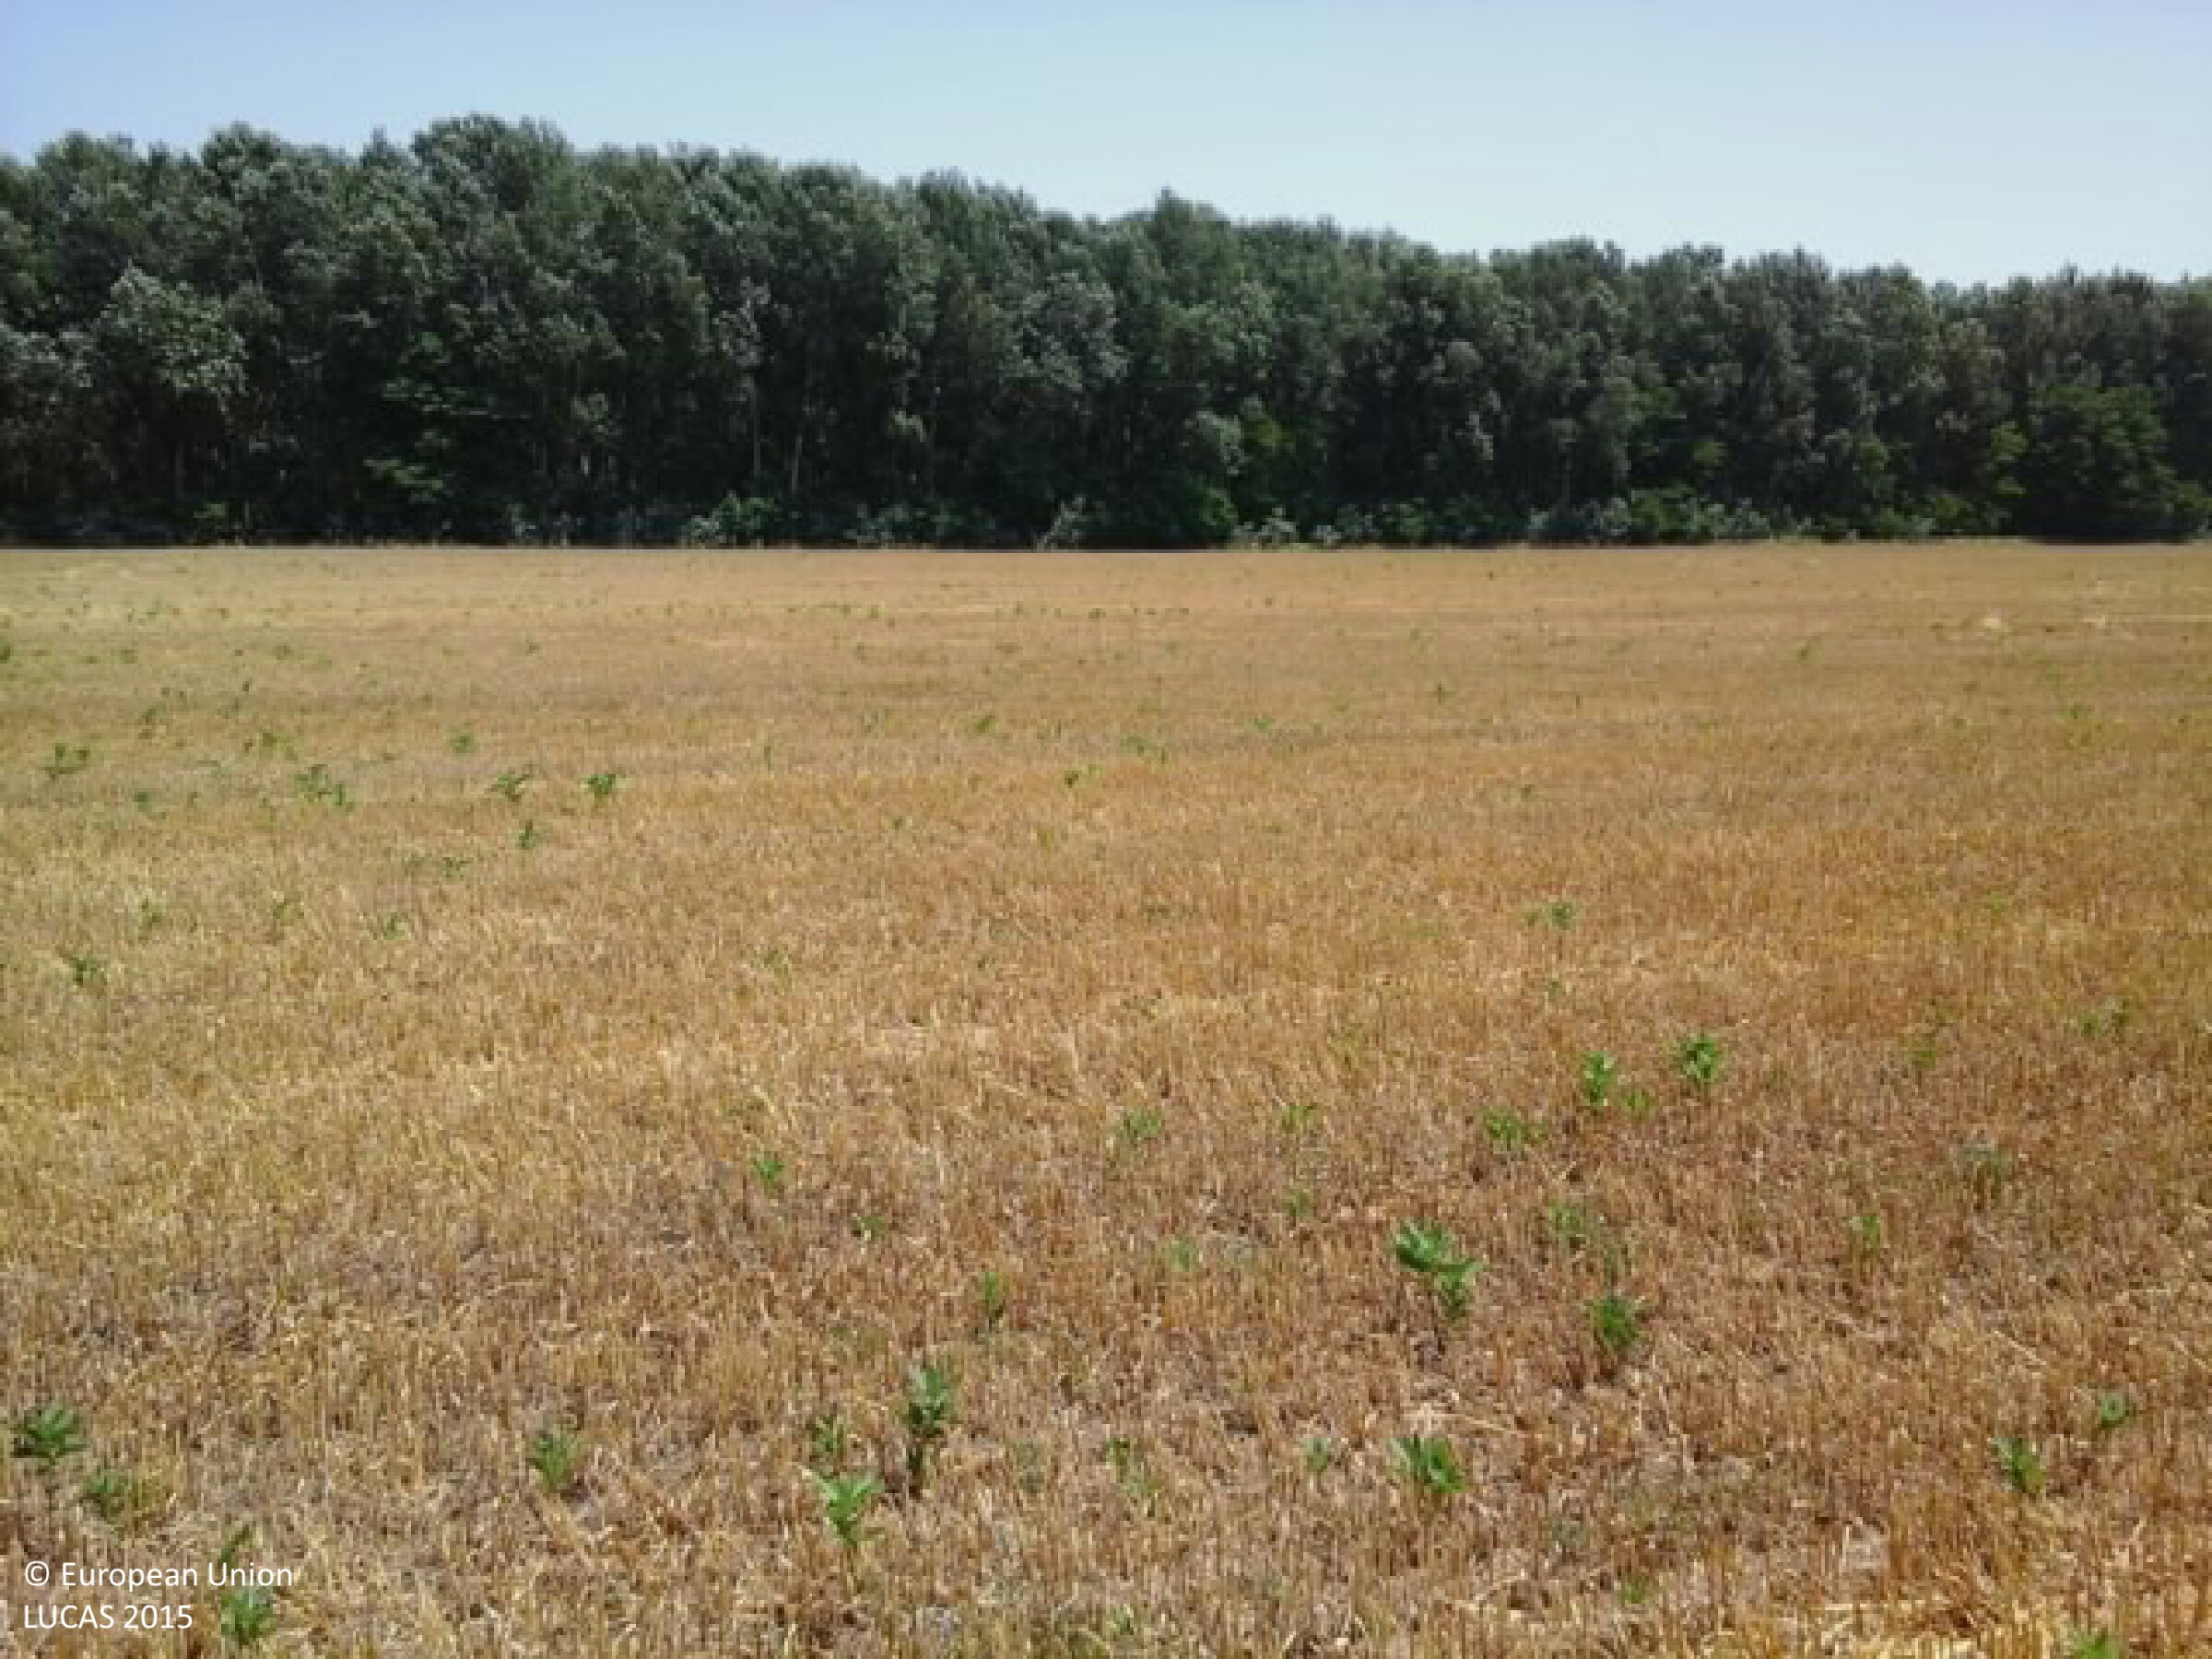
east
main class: Cropland
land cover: Barley
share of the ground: 25 - 50 %
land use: Agriculture (excluding fallow land and kitchen gardens)
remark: Harvested field
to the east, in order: Barley; Grass margins; Broadleaved woodland
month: July
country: HU
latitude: 46.0778
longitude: 19.4415
